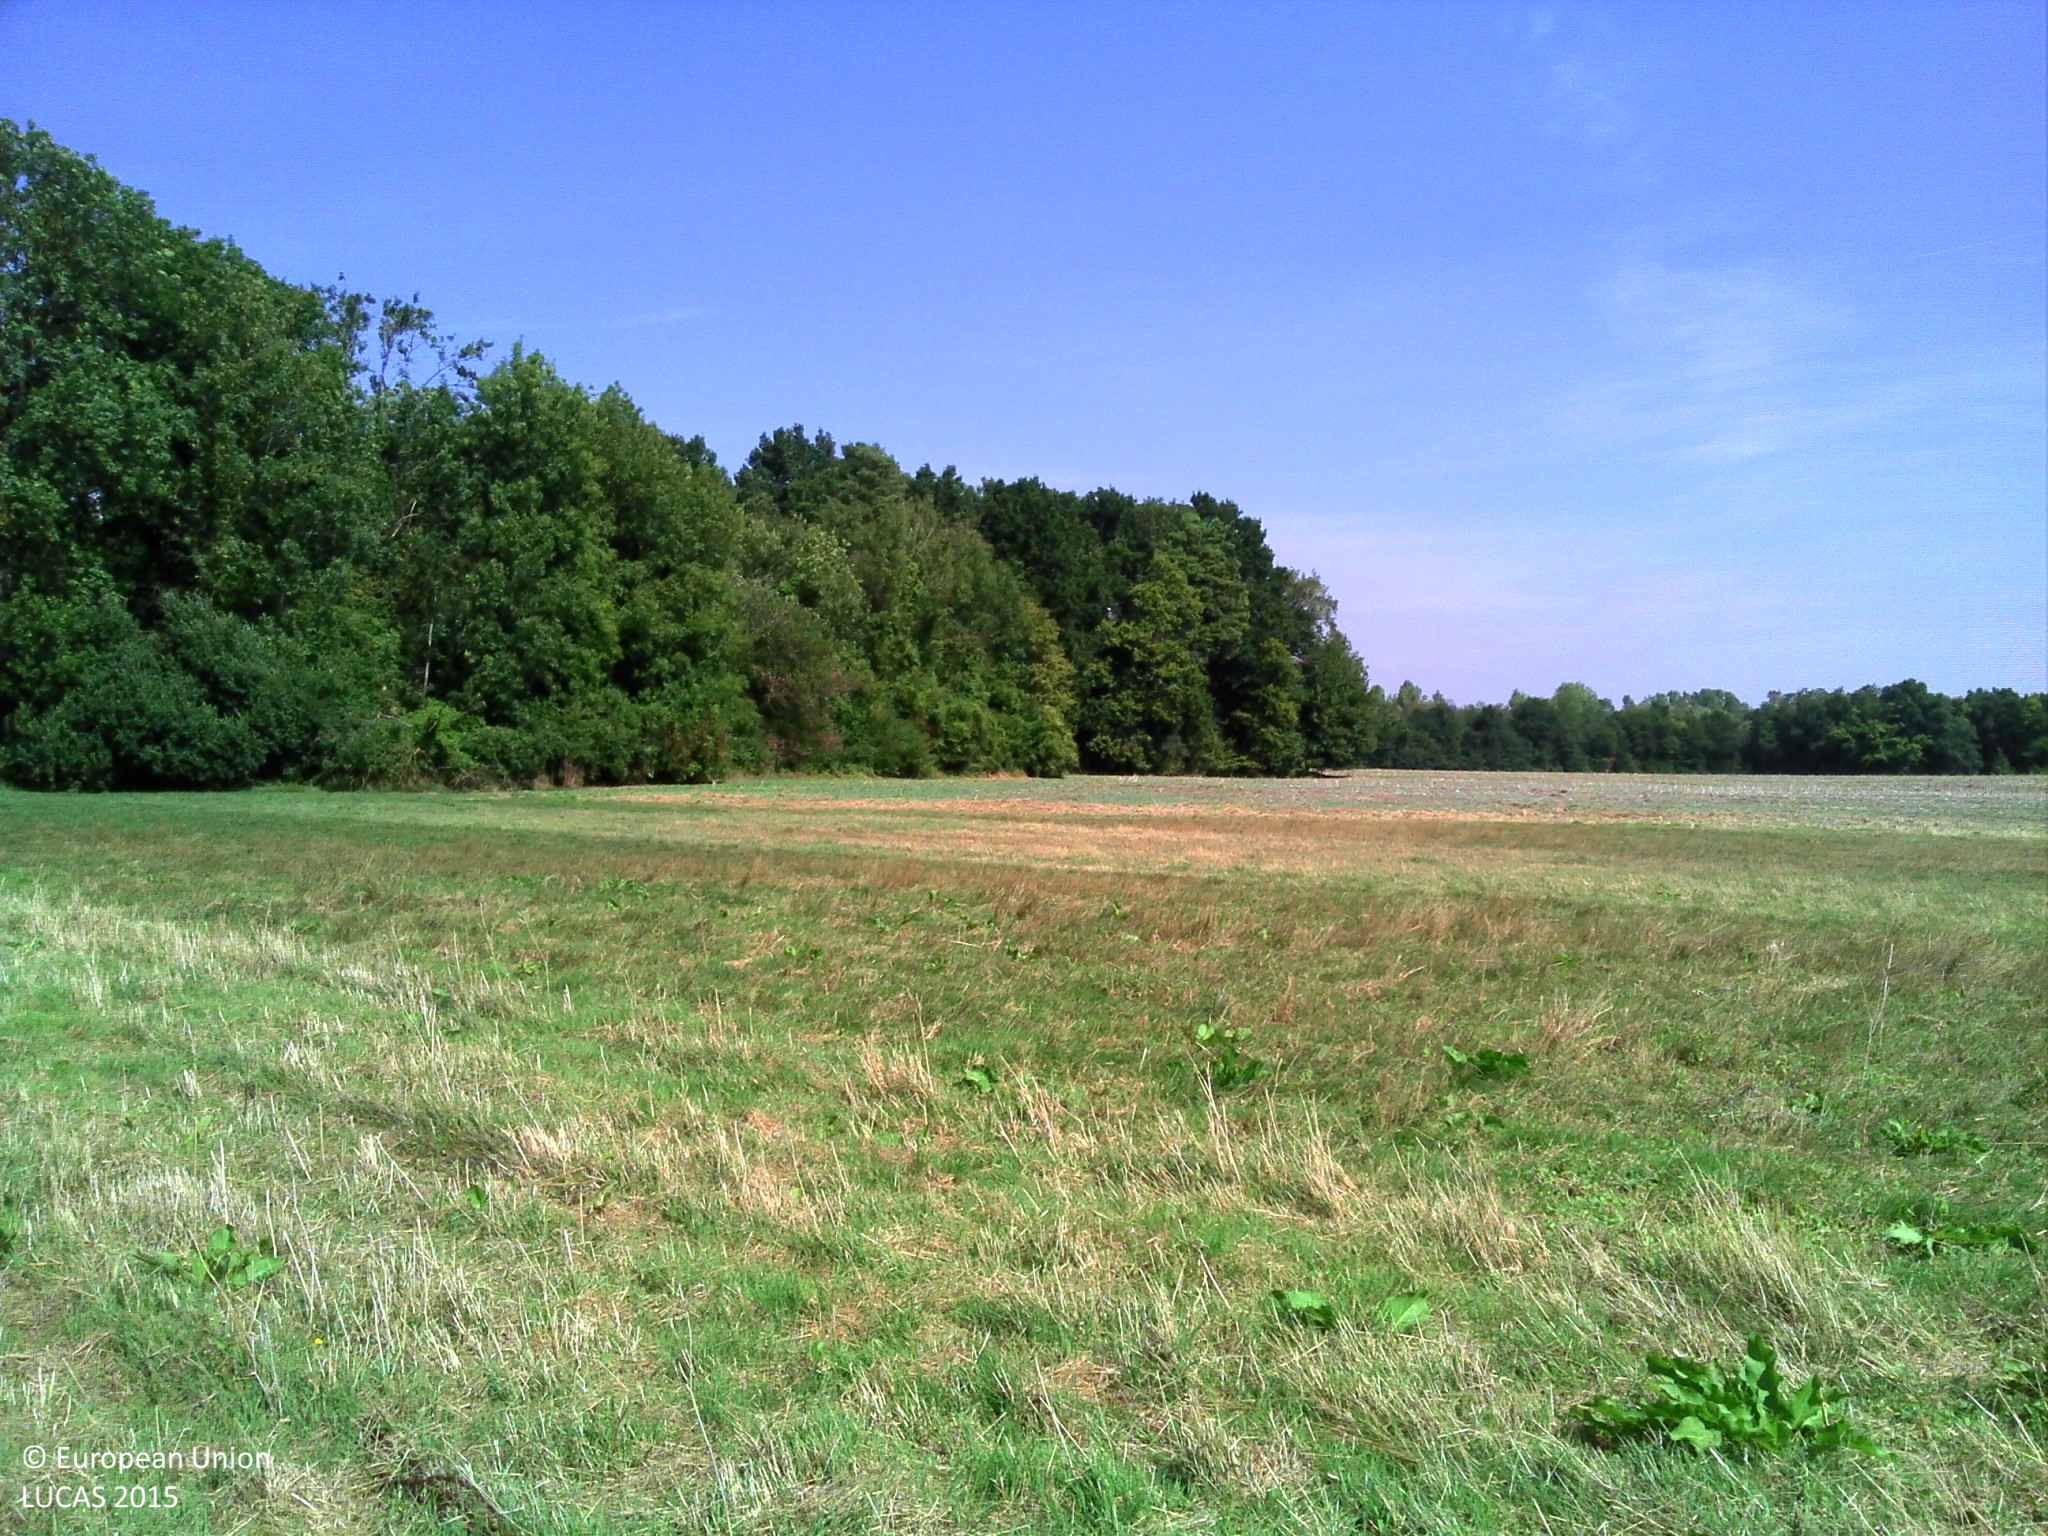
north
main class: Grassland
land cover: Grassland without tree/shrub cover
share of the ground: > 75 %
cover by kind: herbaceous plants 100 %
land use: Agriculture (excluding fallow land and kitchen gardens)
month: August
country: FR
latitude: 48.3081
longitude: 2.7236
